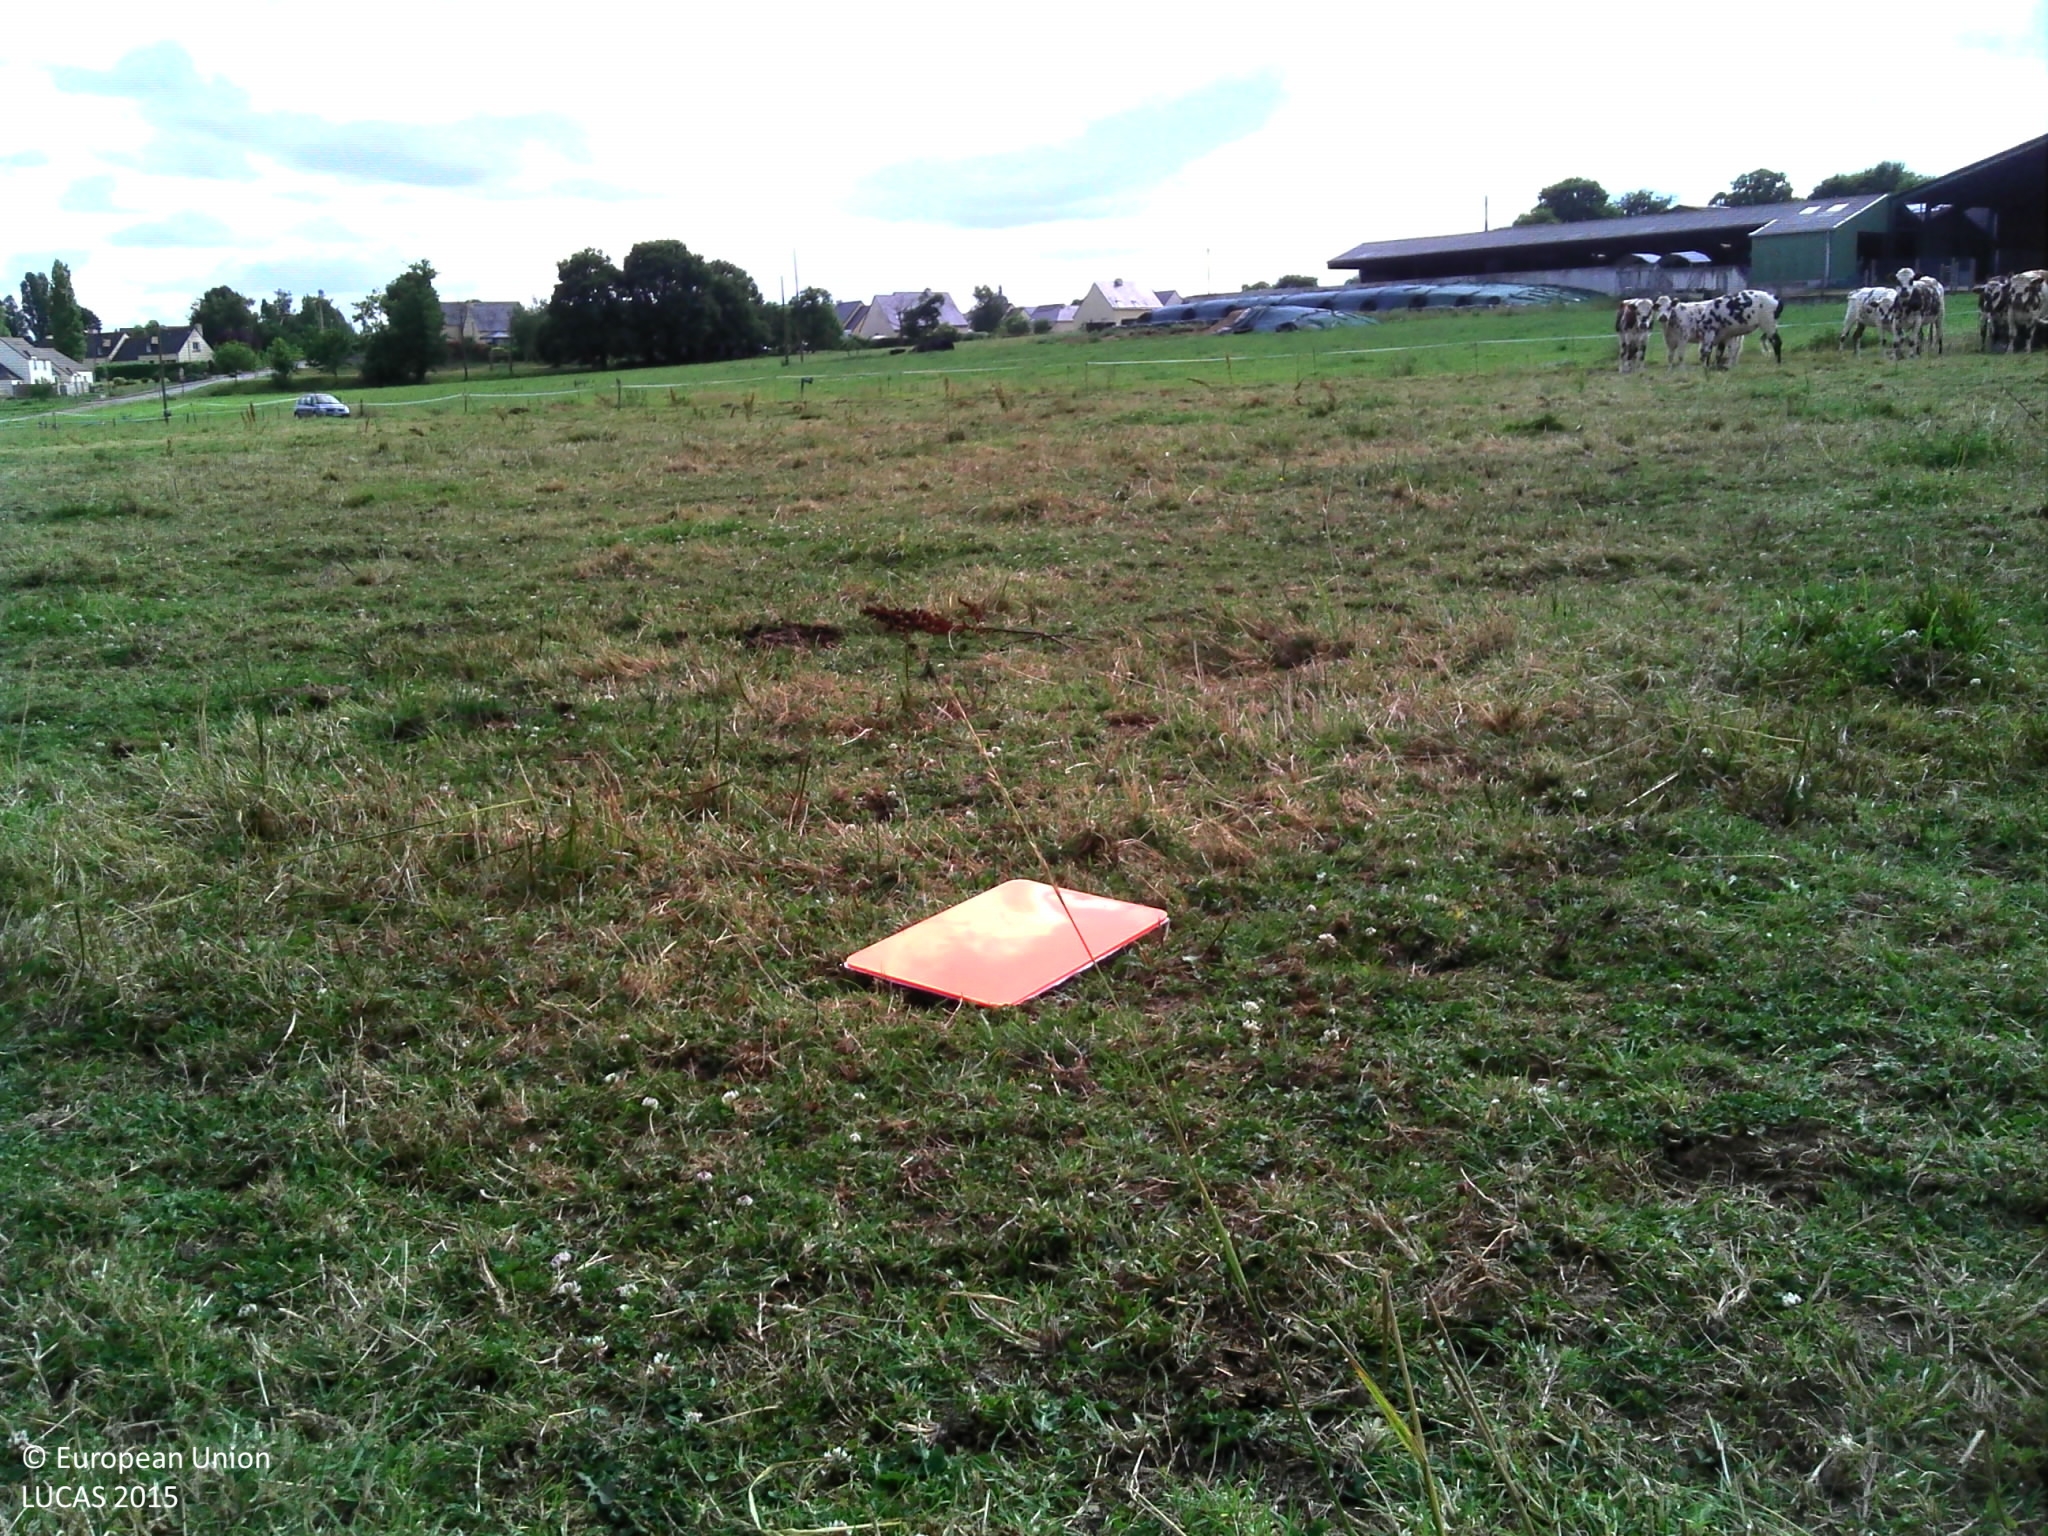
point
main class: Grassland
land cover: Grassland without tree/shrub cover
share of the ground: > 75 %
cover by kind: herbaceous plants 80 %, unconsolidated bare surface 20 %
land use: Agriculture (excluding fallow land and kitchen gardens)
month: July
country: FR
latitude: 48.2950
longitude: -2.1465
